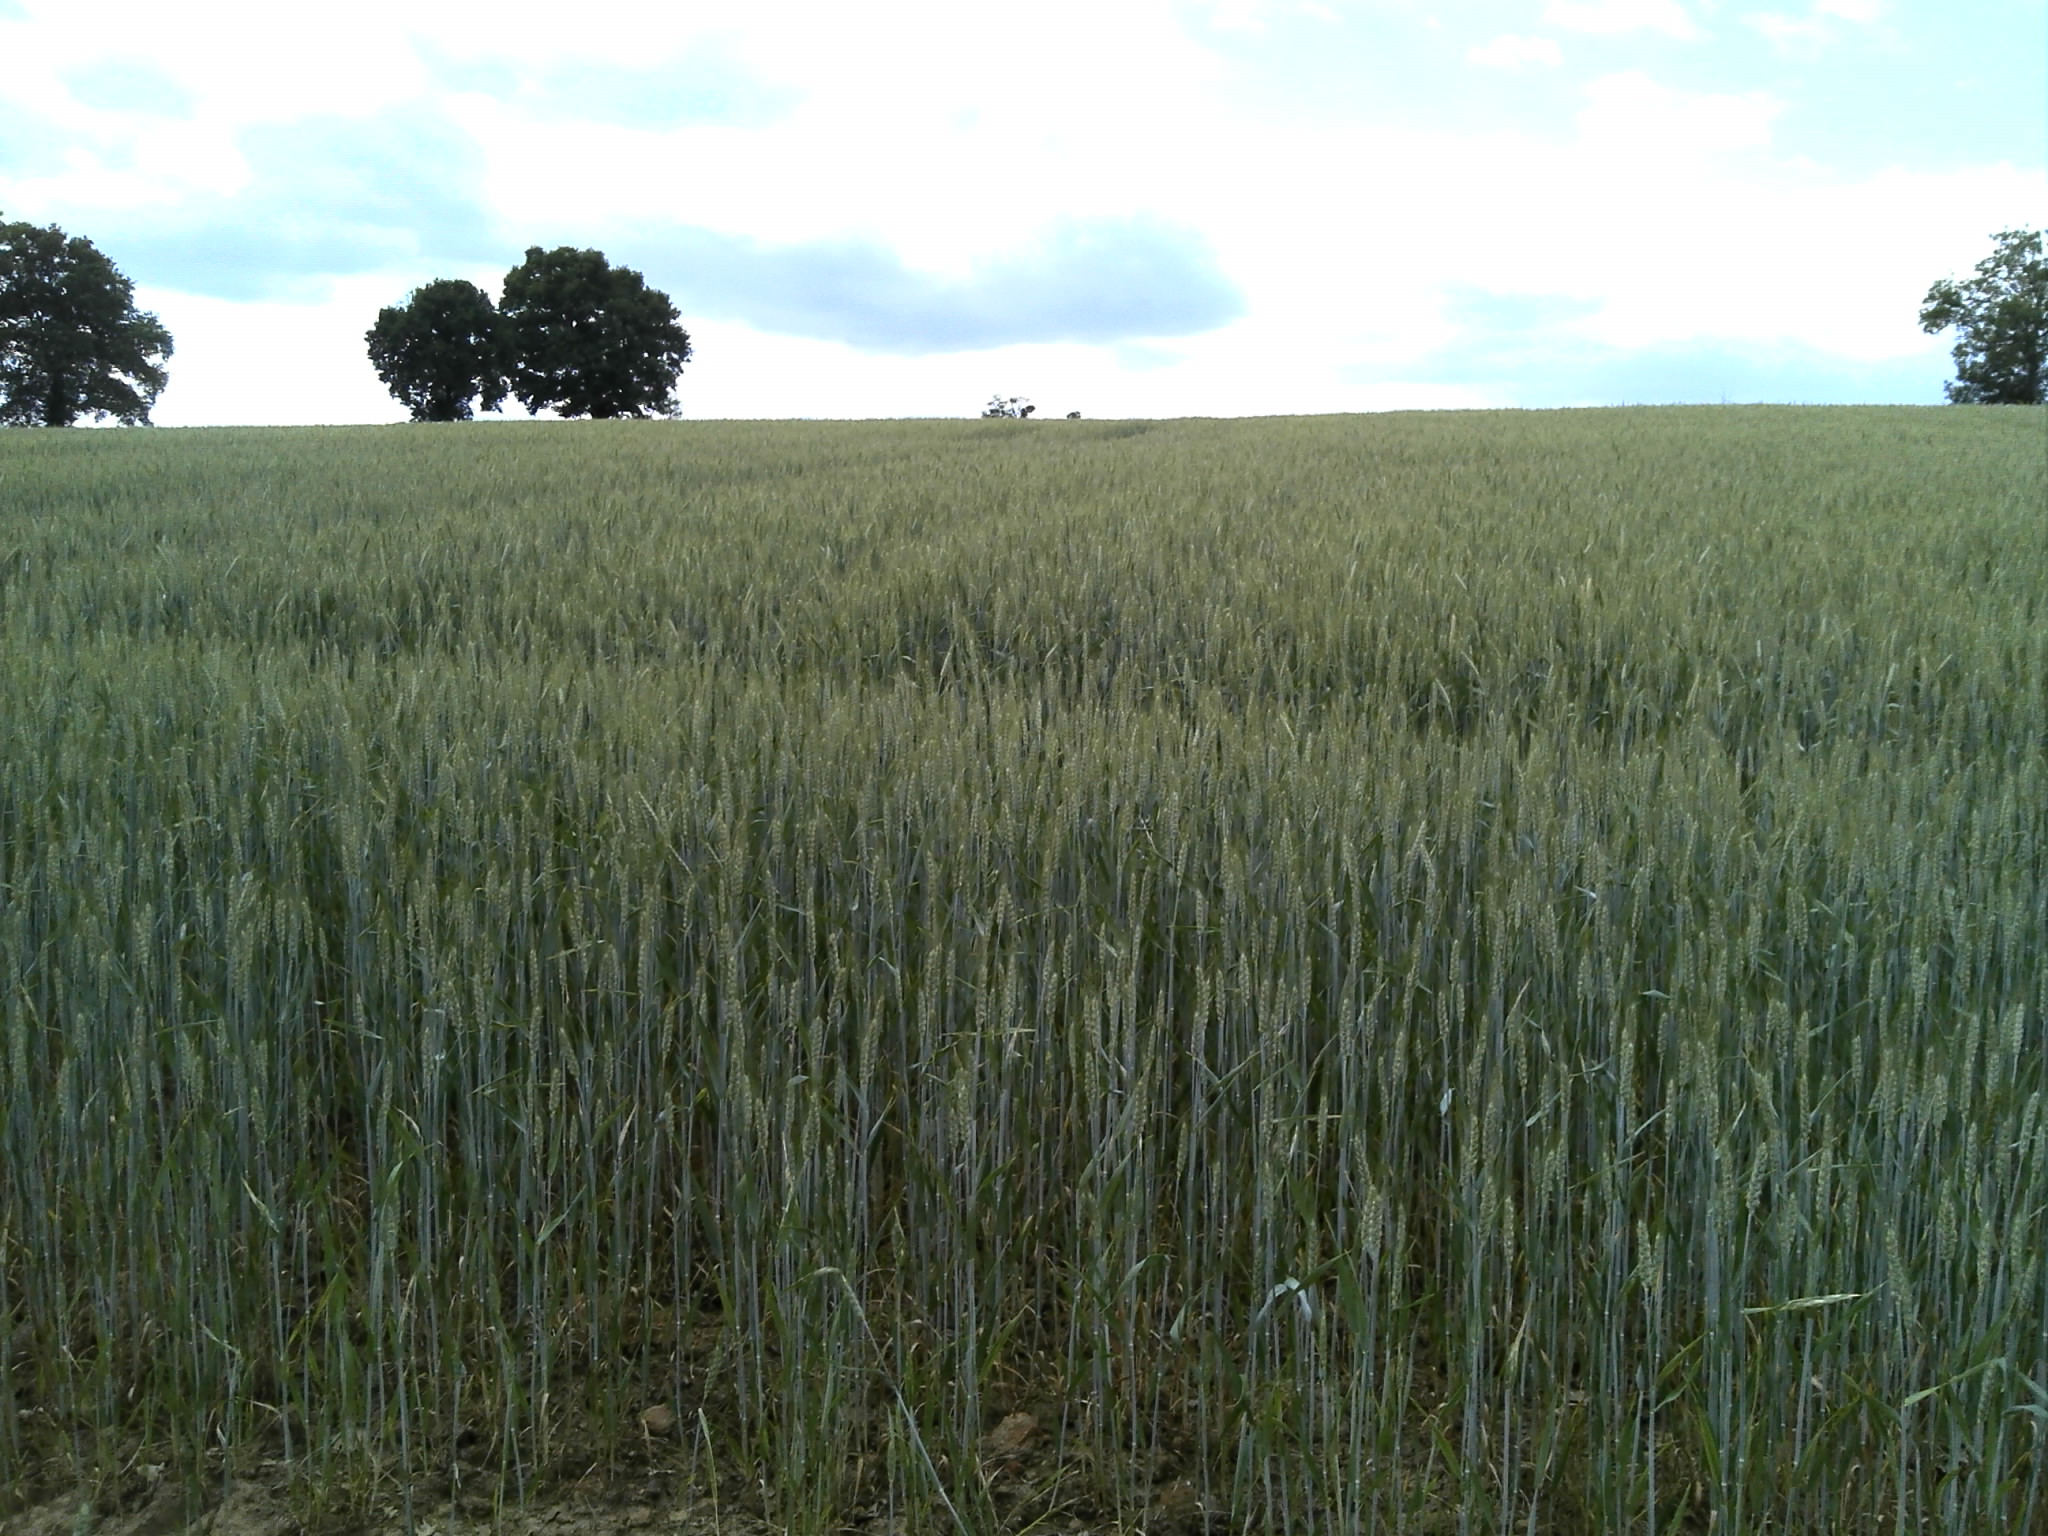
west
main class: Cropland
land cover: Common wheat
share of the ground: > 75 %
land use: Agriculture (excluding fallow land and kitchen gardens)
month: May
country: FR
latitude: 46.5912
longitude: 1.4924
